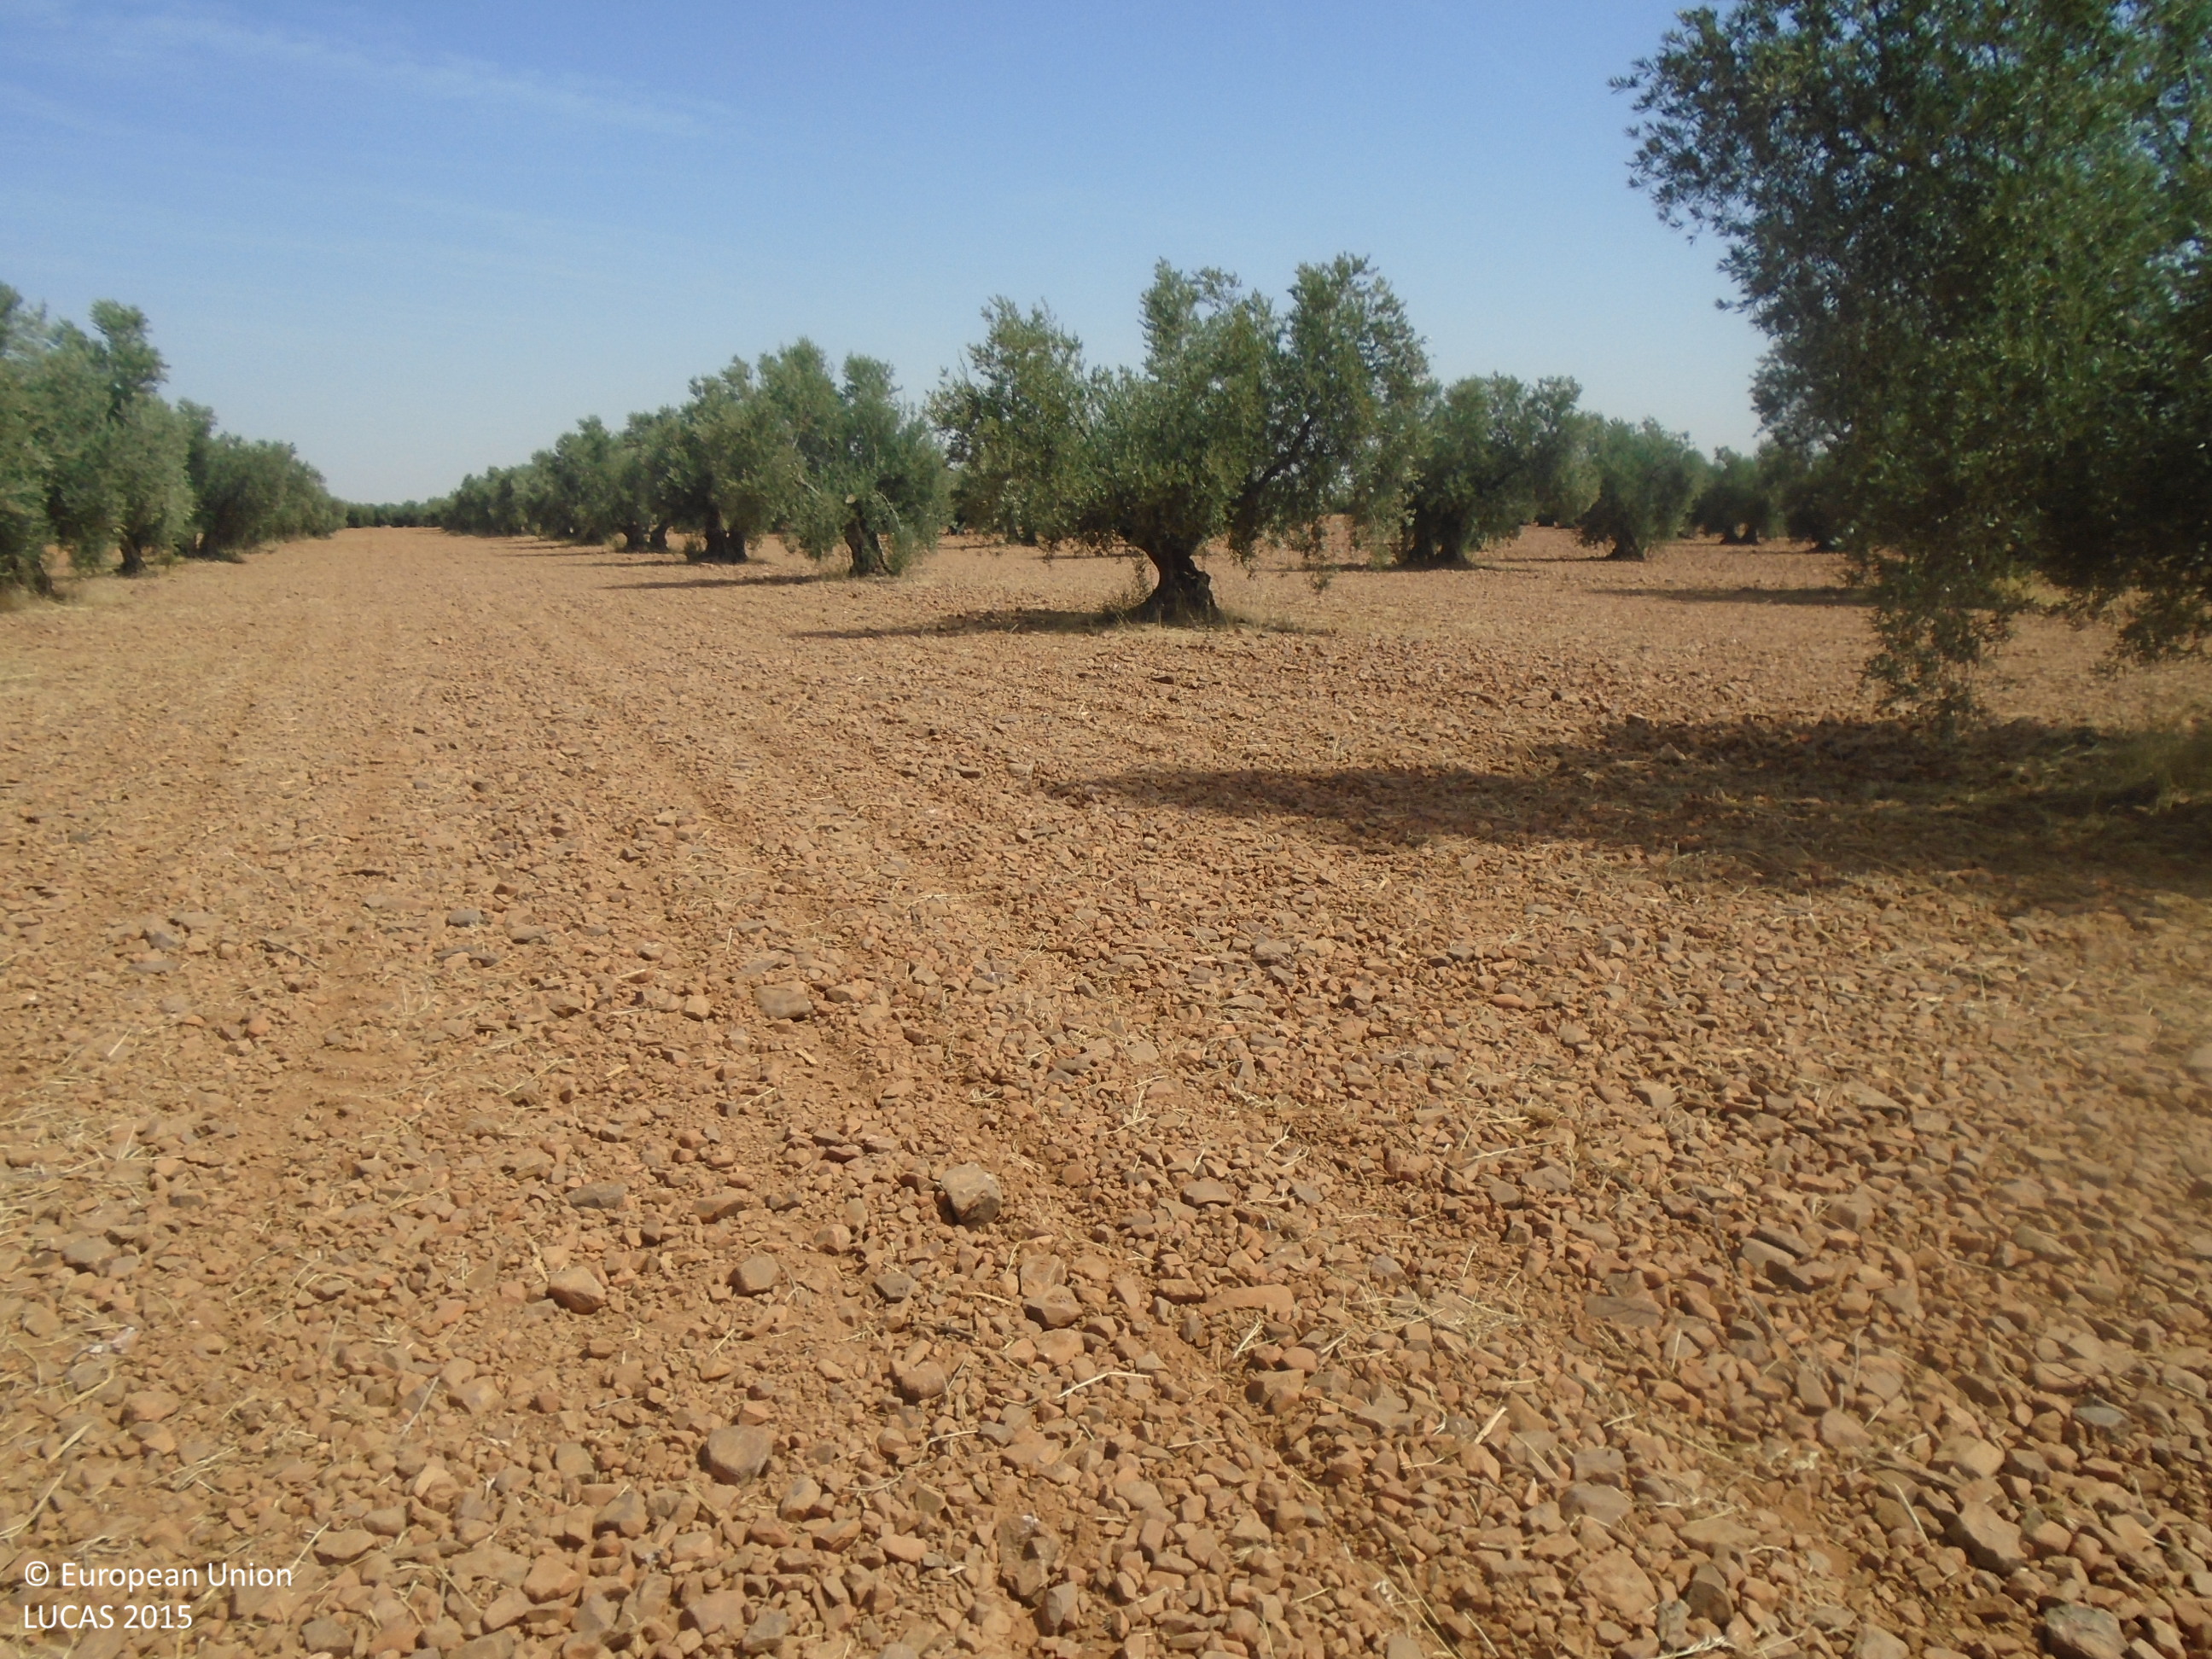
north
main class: Cropland
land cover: Olive groves
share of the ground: 25 - 50 %
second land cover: Other bare soil
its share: > 75 %
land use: Agriculture (excluding fallow land and kitchen gardens)
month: July
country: ES
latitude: 39.3927
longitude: -3.5722
